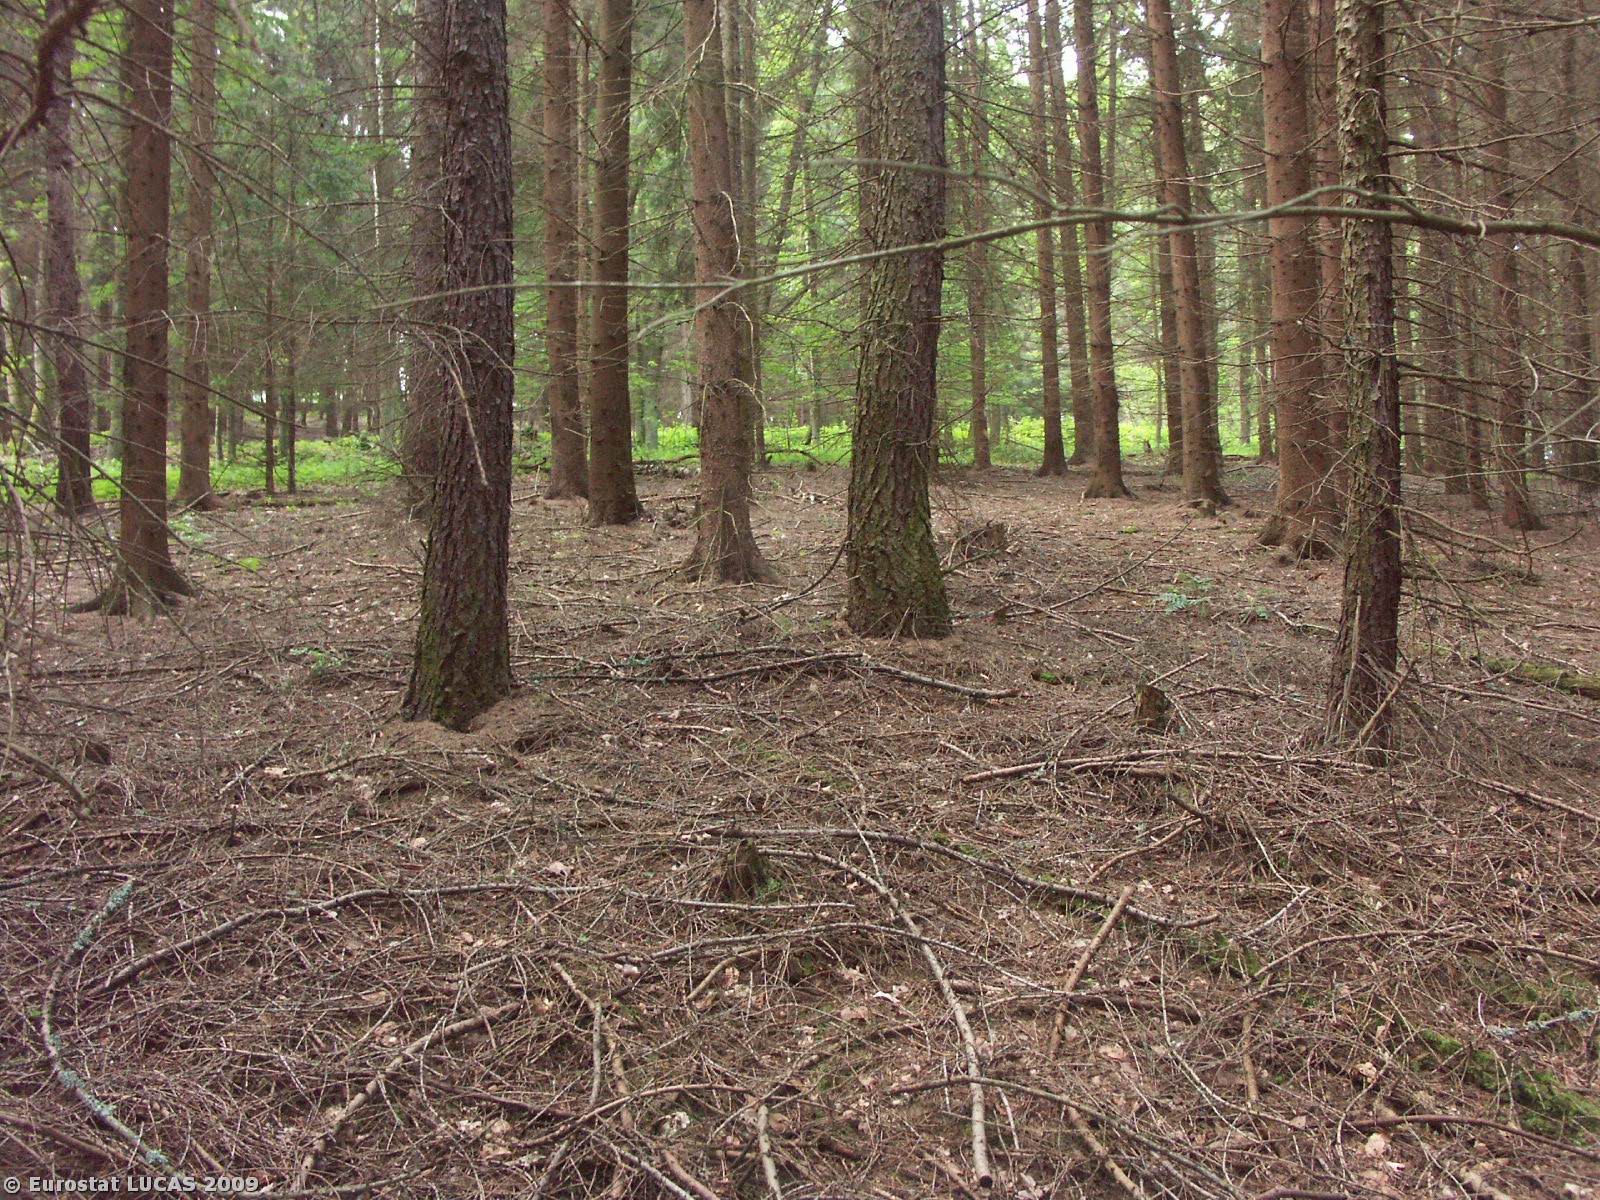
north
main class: Woodland
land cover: Coniferous woodland
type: hemiboreal forest and nemoral coniferous forest and mixed broadleaved-coniferous forest
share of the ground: > 75 %
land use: Forestry
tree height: > 5 m
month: June
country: CZ
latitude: 49.9267
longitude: 17.1005
